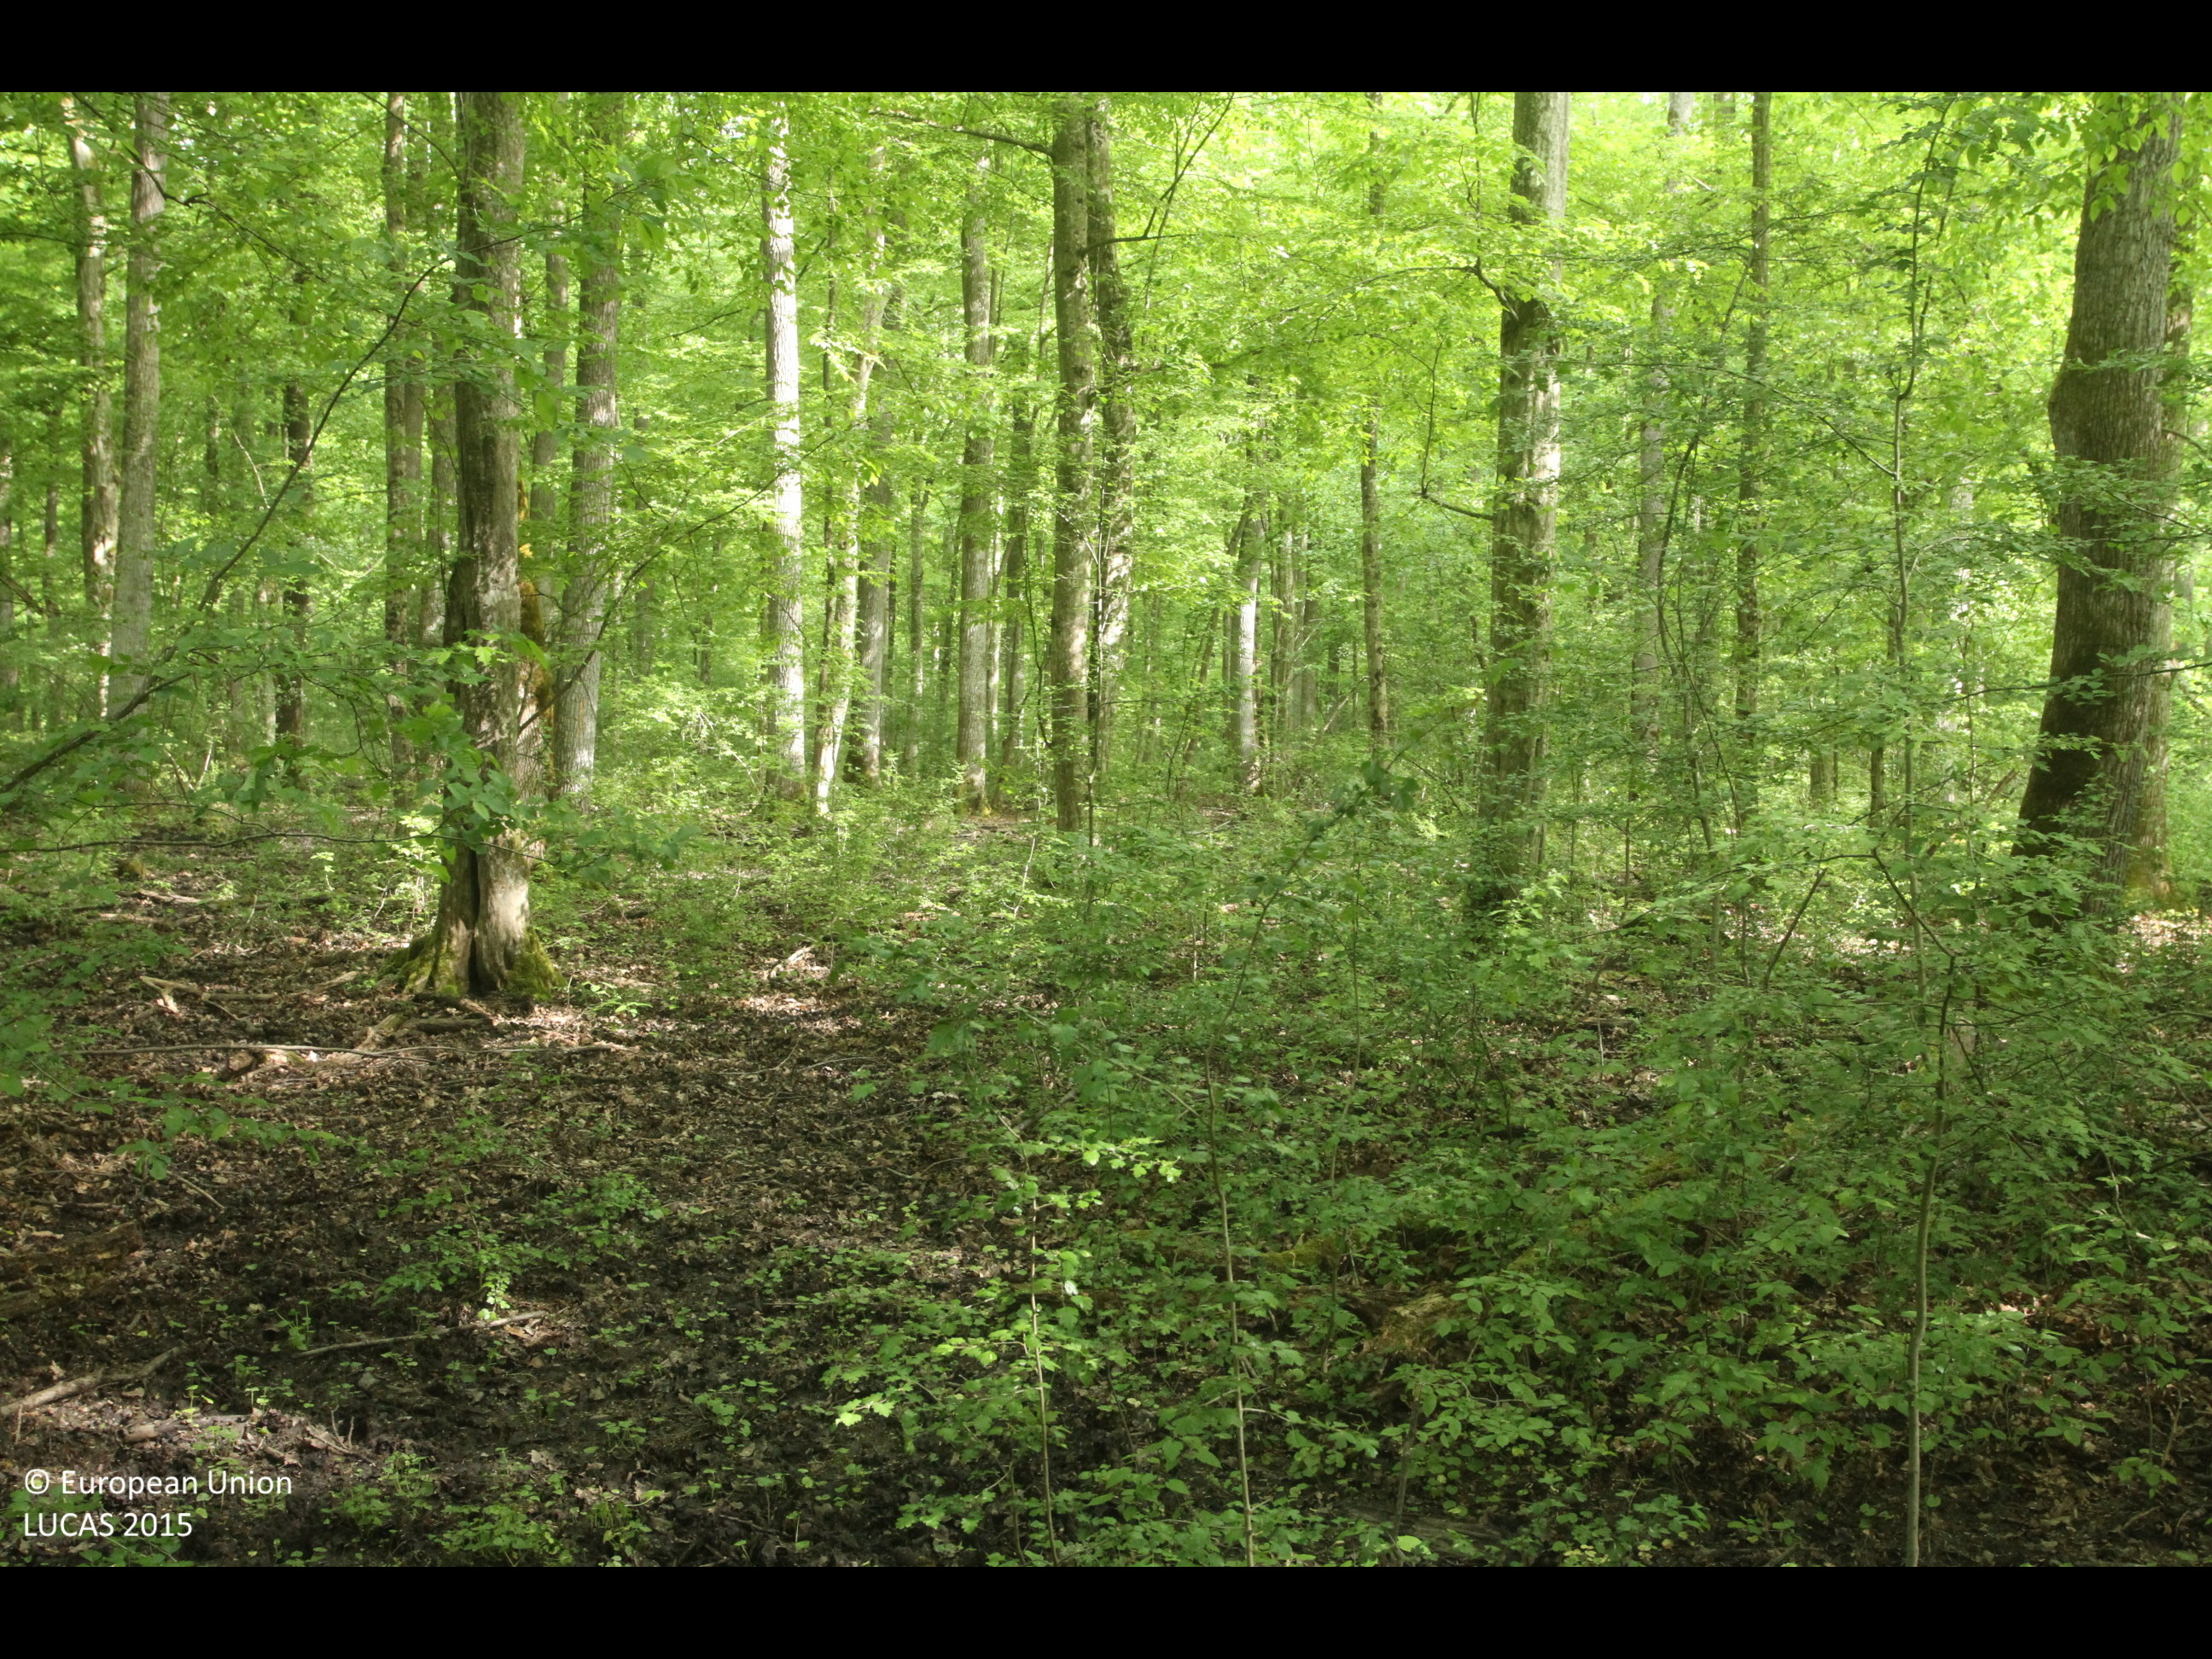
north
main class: Woodland
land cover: Broadleaved woodland
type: mesophytic deciduous forest
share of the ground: > 75 %
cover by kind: broadleaved forest trees 100 %
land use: Forestry
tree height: > 5 m
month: April
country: HR
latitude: 45.0260
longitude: 19.0312
